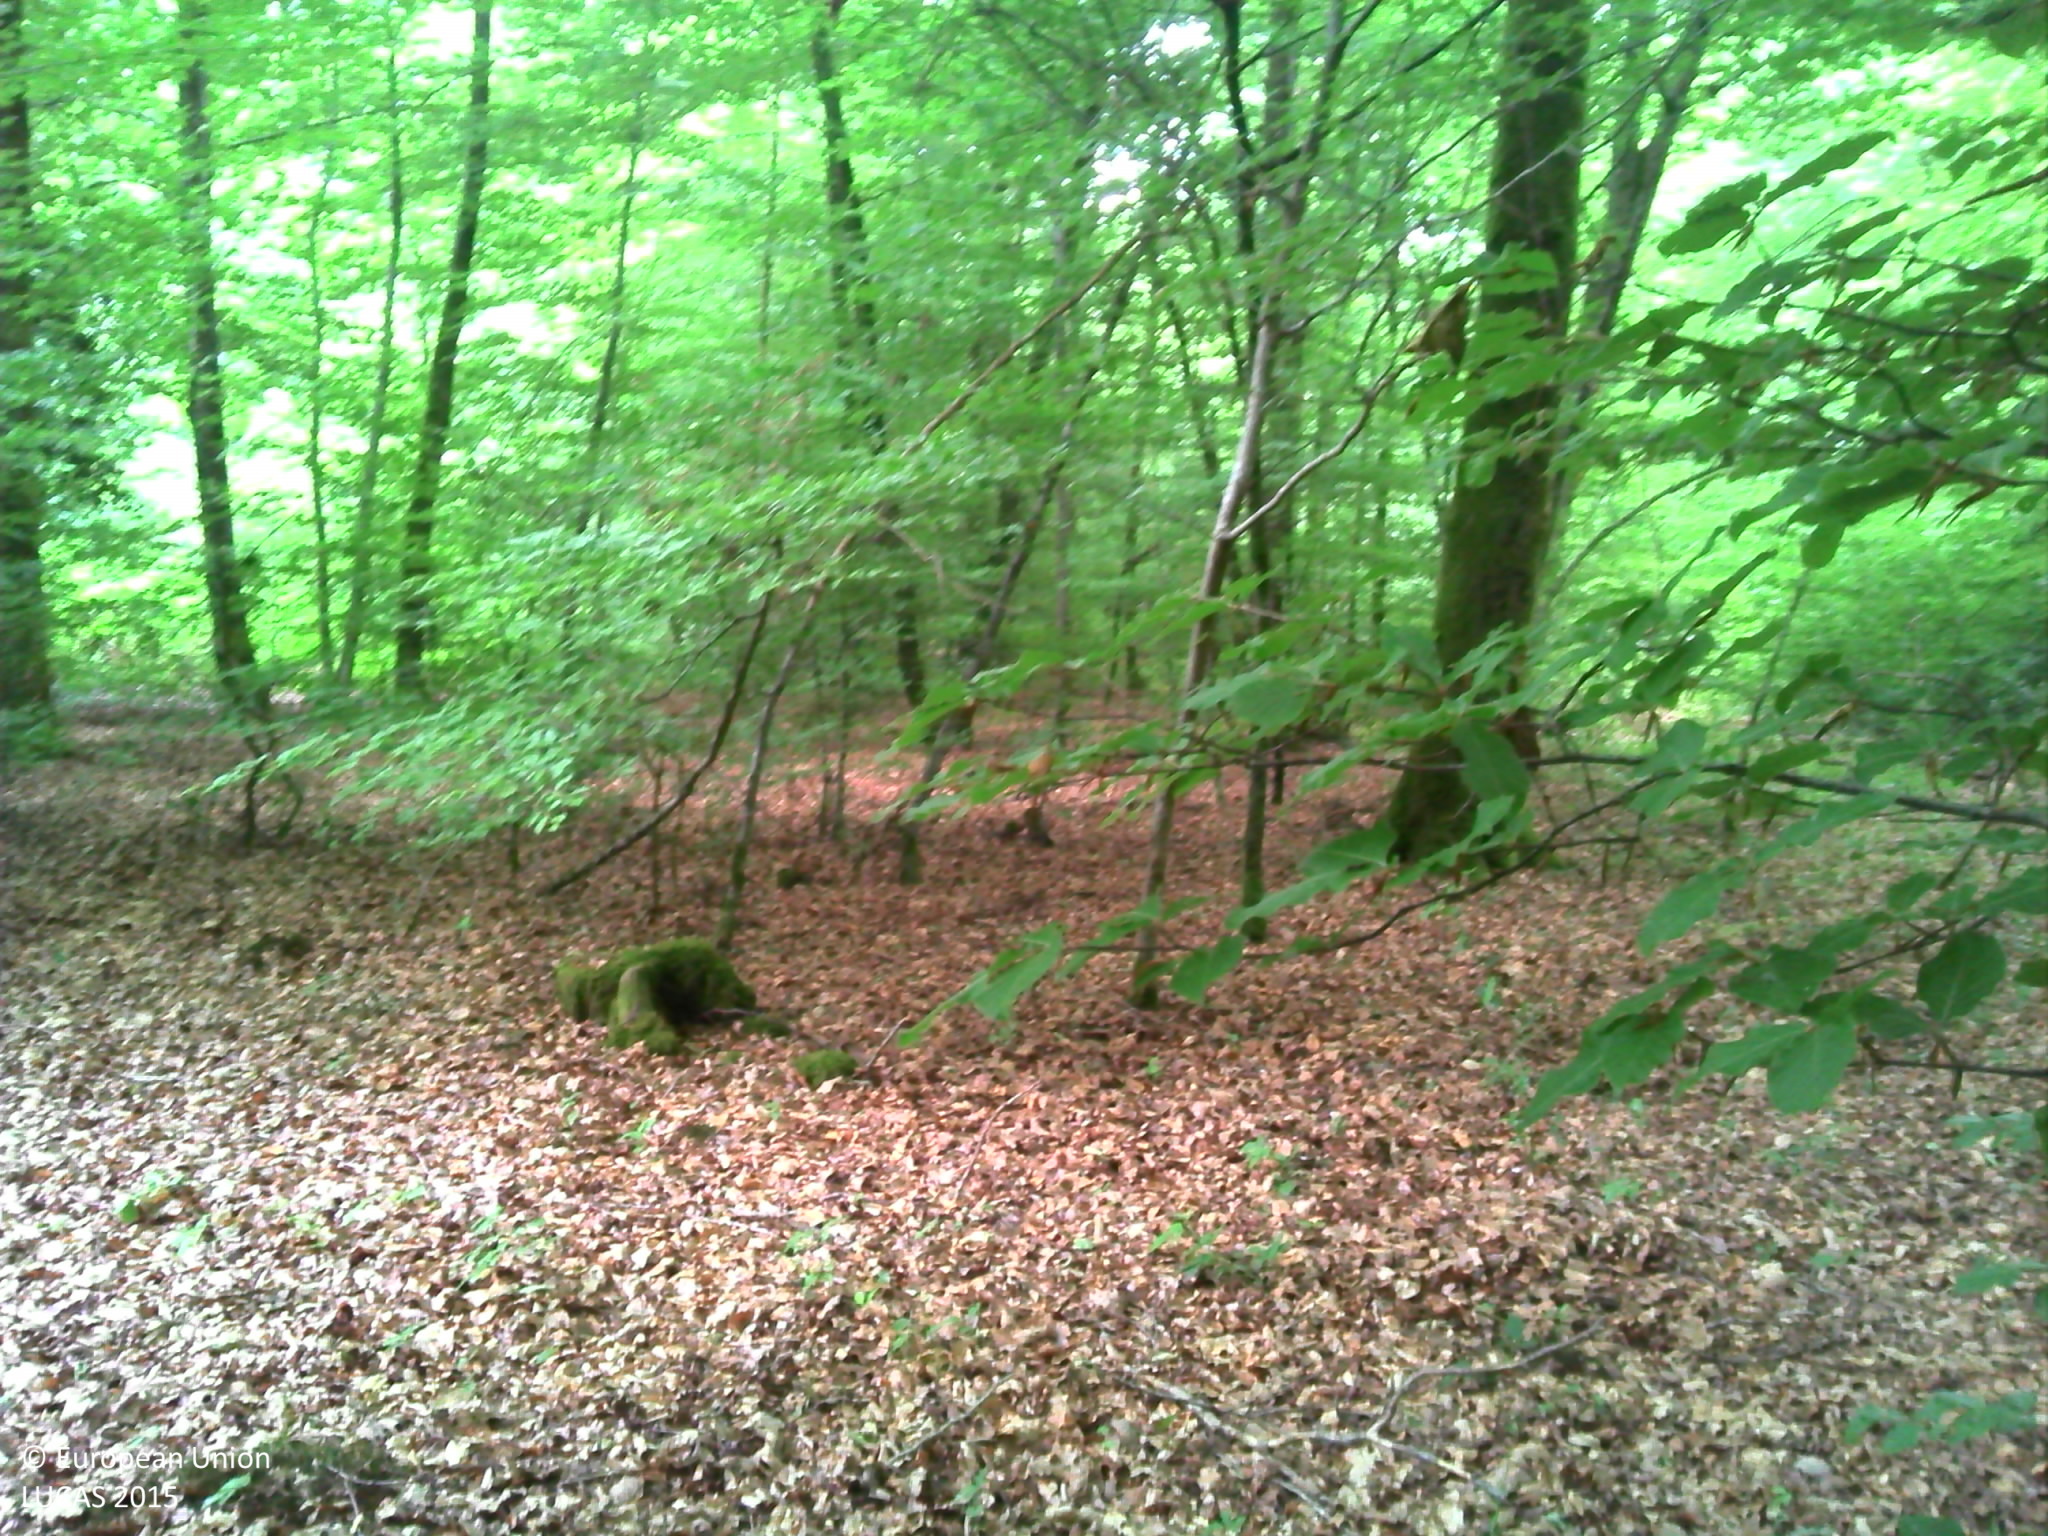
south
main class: Woodland
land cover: Broadleaved woodland
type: beech forest
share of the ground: > 75 %
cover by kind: broadleaved forest trees 85 %, unconsolidated bare surface 10 %, herbaceous plants 5 %
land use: Forestry
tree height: > 5 m
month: June
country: FR
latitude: 47.5326
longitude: 6.3486
